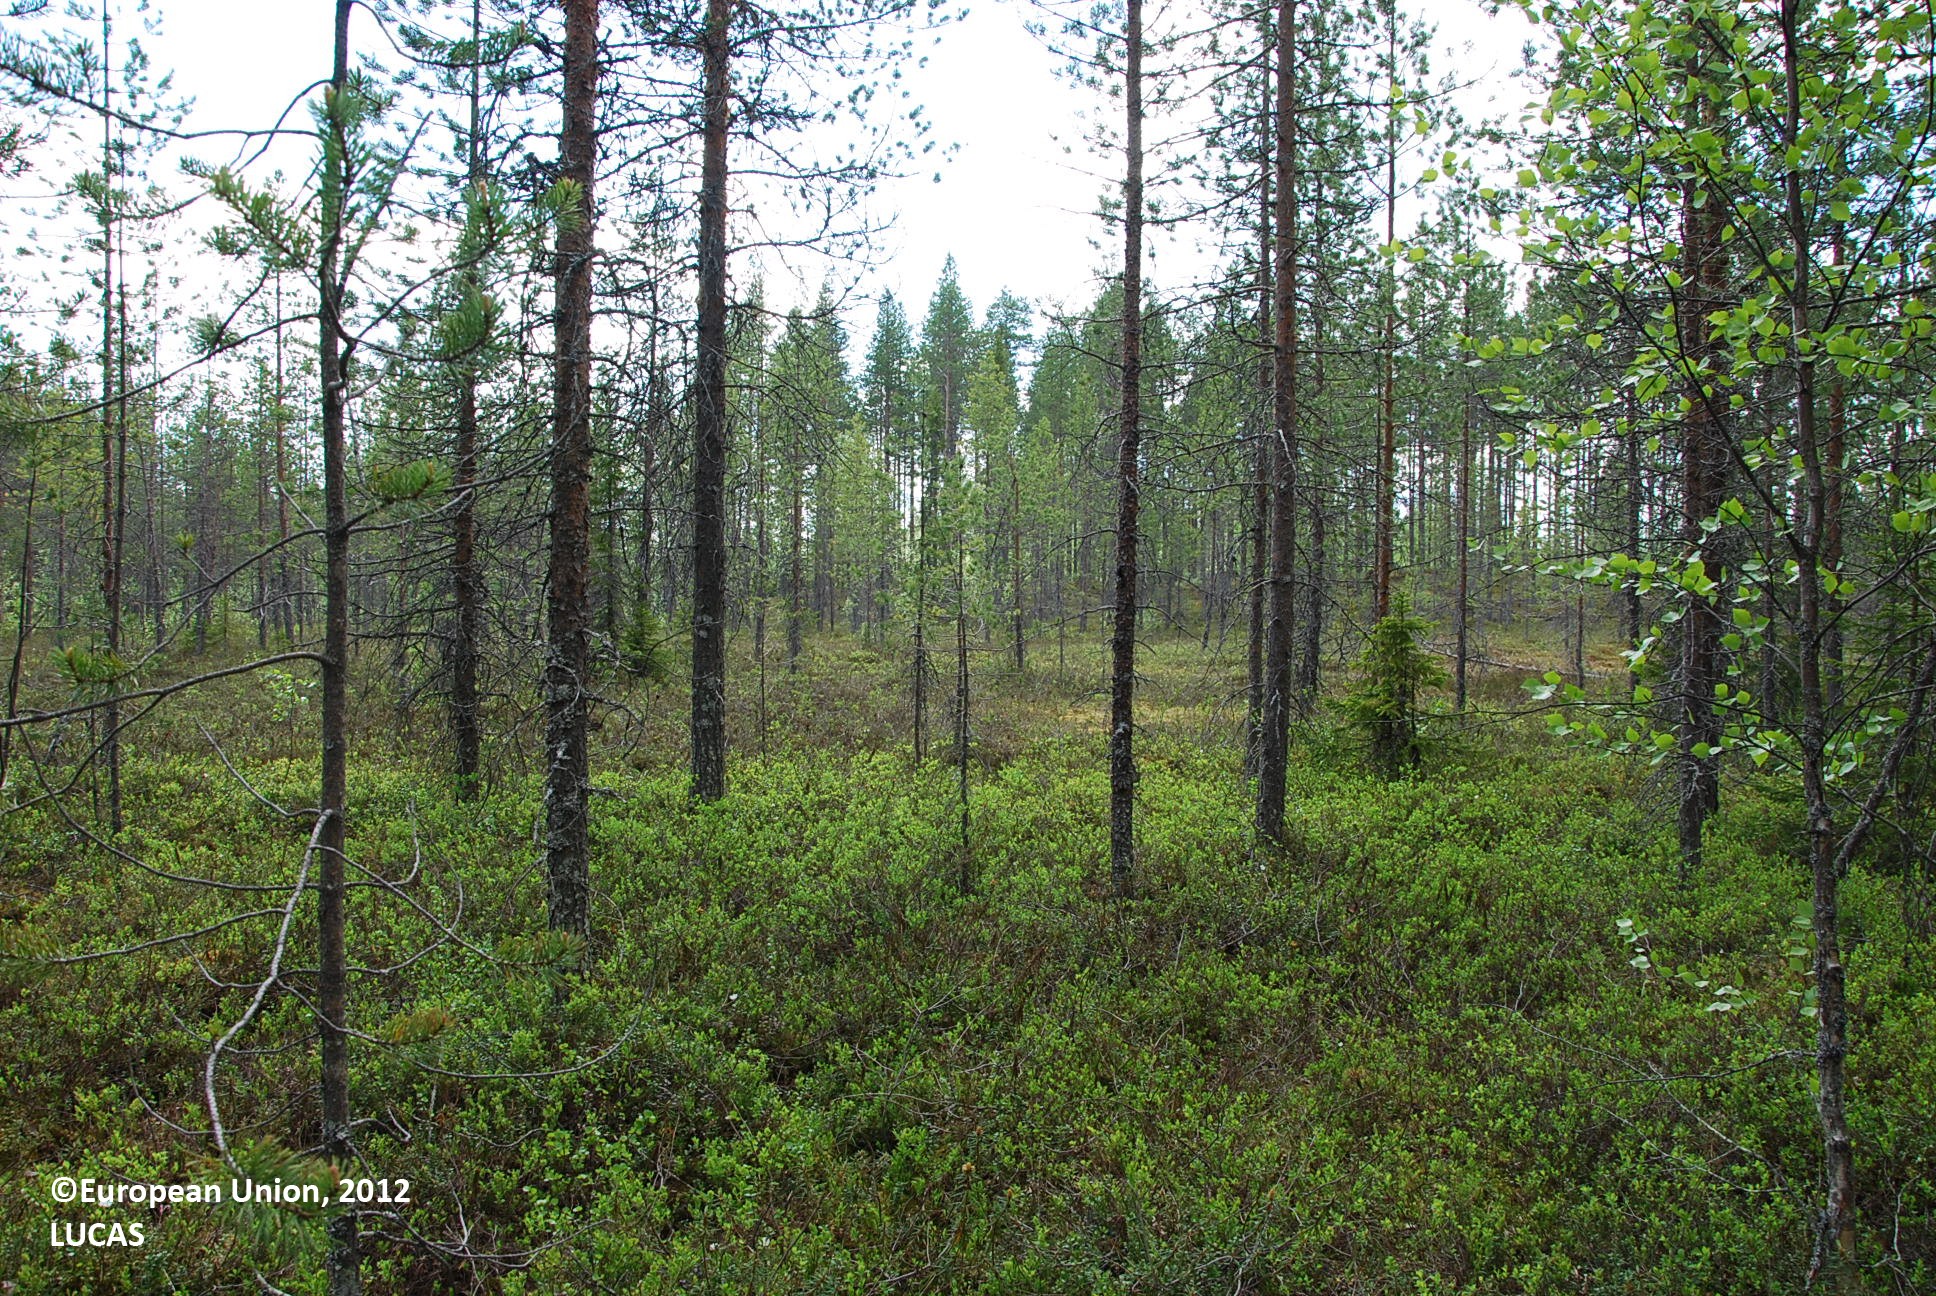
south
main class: Woodland
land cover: Pine dominated coniferous woodland
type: boreal forest
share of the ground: > 75 %
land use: Forestry
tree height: > 5 m
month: June
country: FI
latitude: 65.9762
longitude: 27.3994
